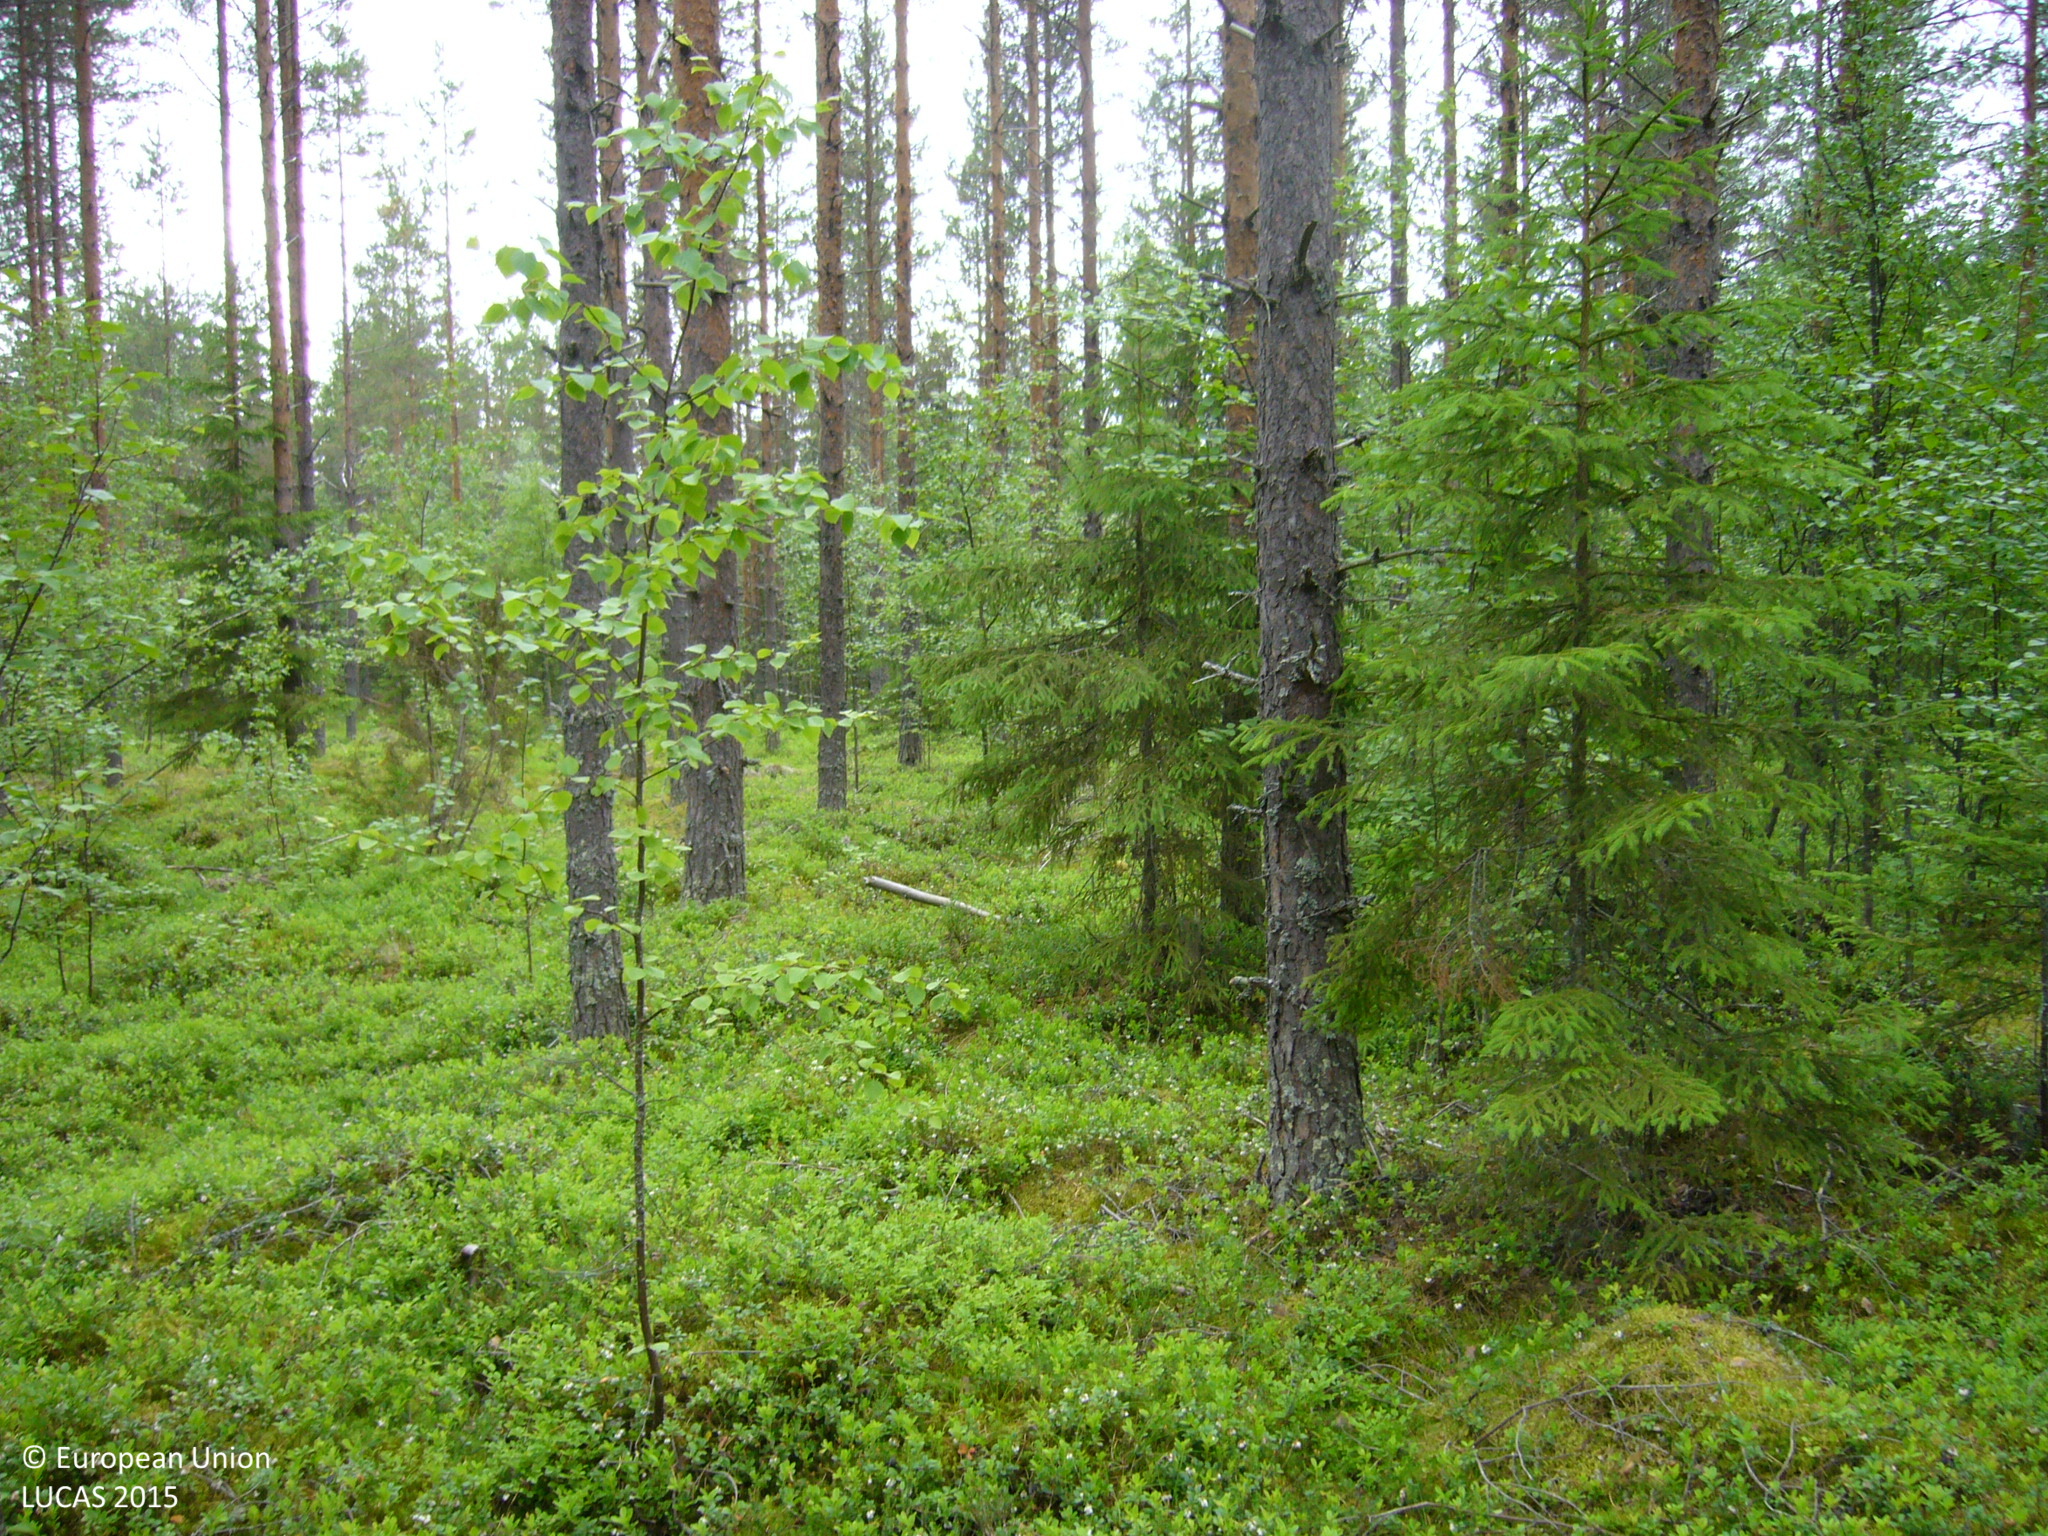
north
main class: Woodland
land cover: Pine dominated mixed woodland
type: boreal forest
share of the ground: 50 - 75 %
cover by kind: coniferous forest trees 50 %, shrubs 30 %, broadleaved forest trees 20 %
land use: Forestry
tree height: > 5 m
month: July
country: FI
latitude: 63.3126
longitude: 26.0631
